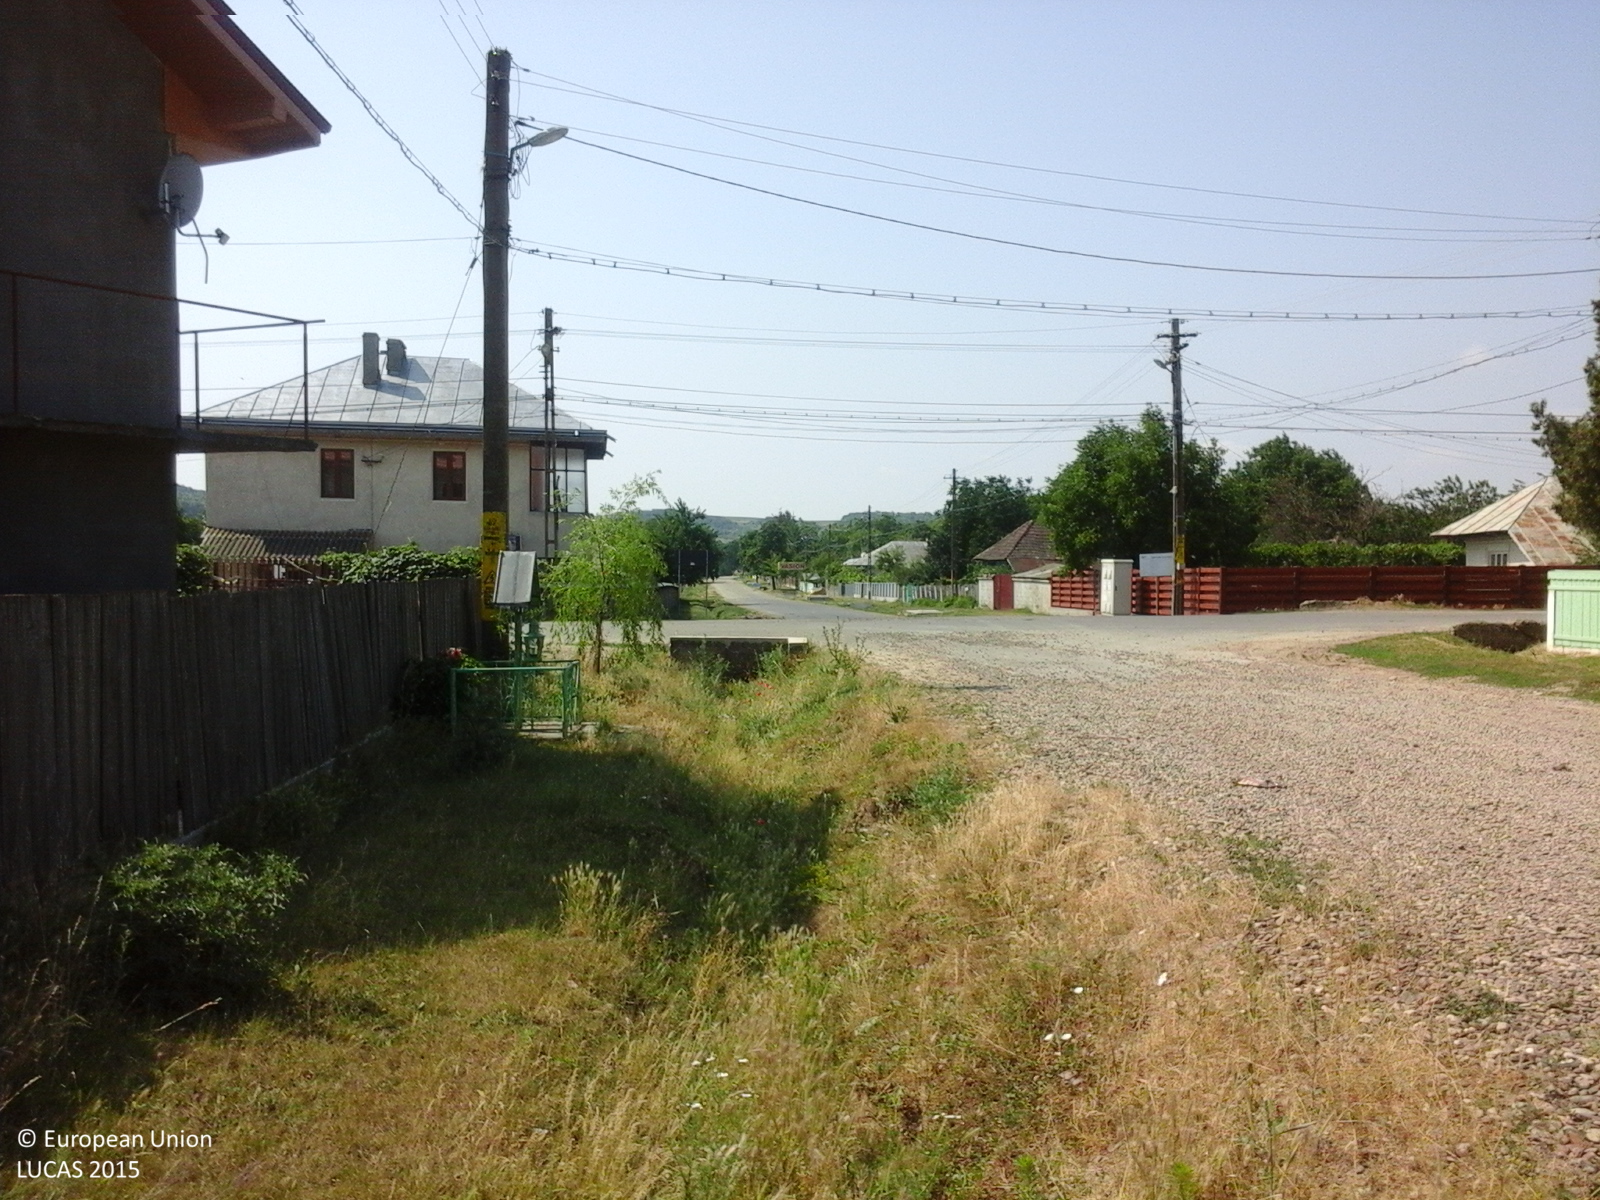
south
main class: Grassland
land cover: Grassland without tree/shrub cover
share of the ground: > 75 %
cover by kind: herbaceous plants 100 %
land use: Residential
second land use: Agriculture (excluding fallow land and kitchen gardens)
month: June
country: RO
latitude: 46.7437
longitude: 26.9952
